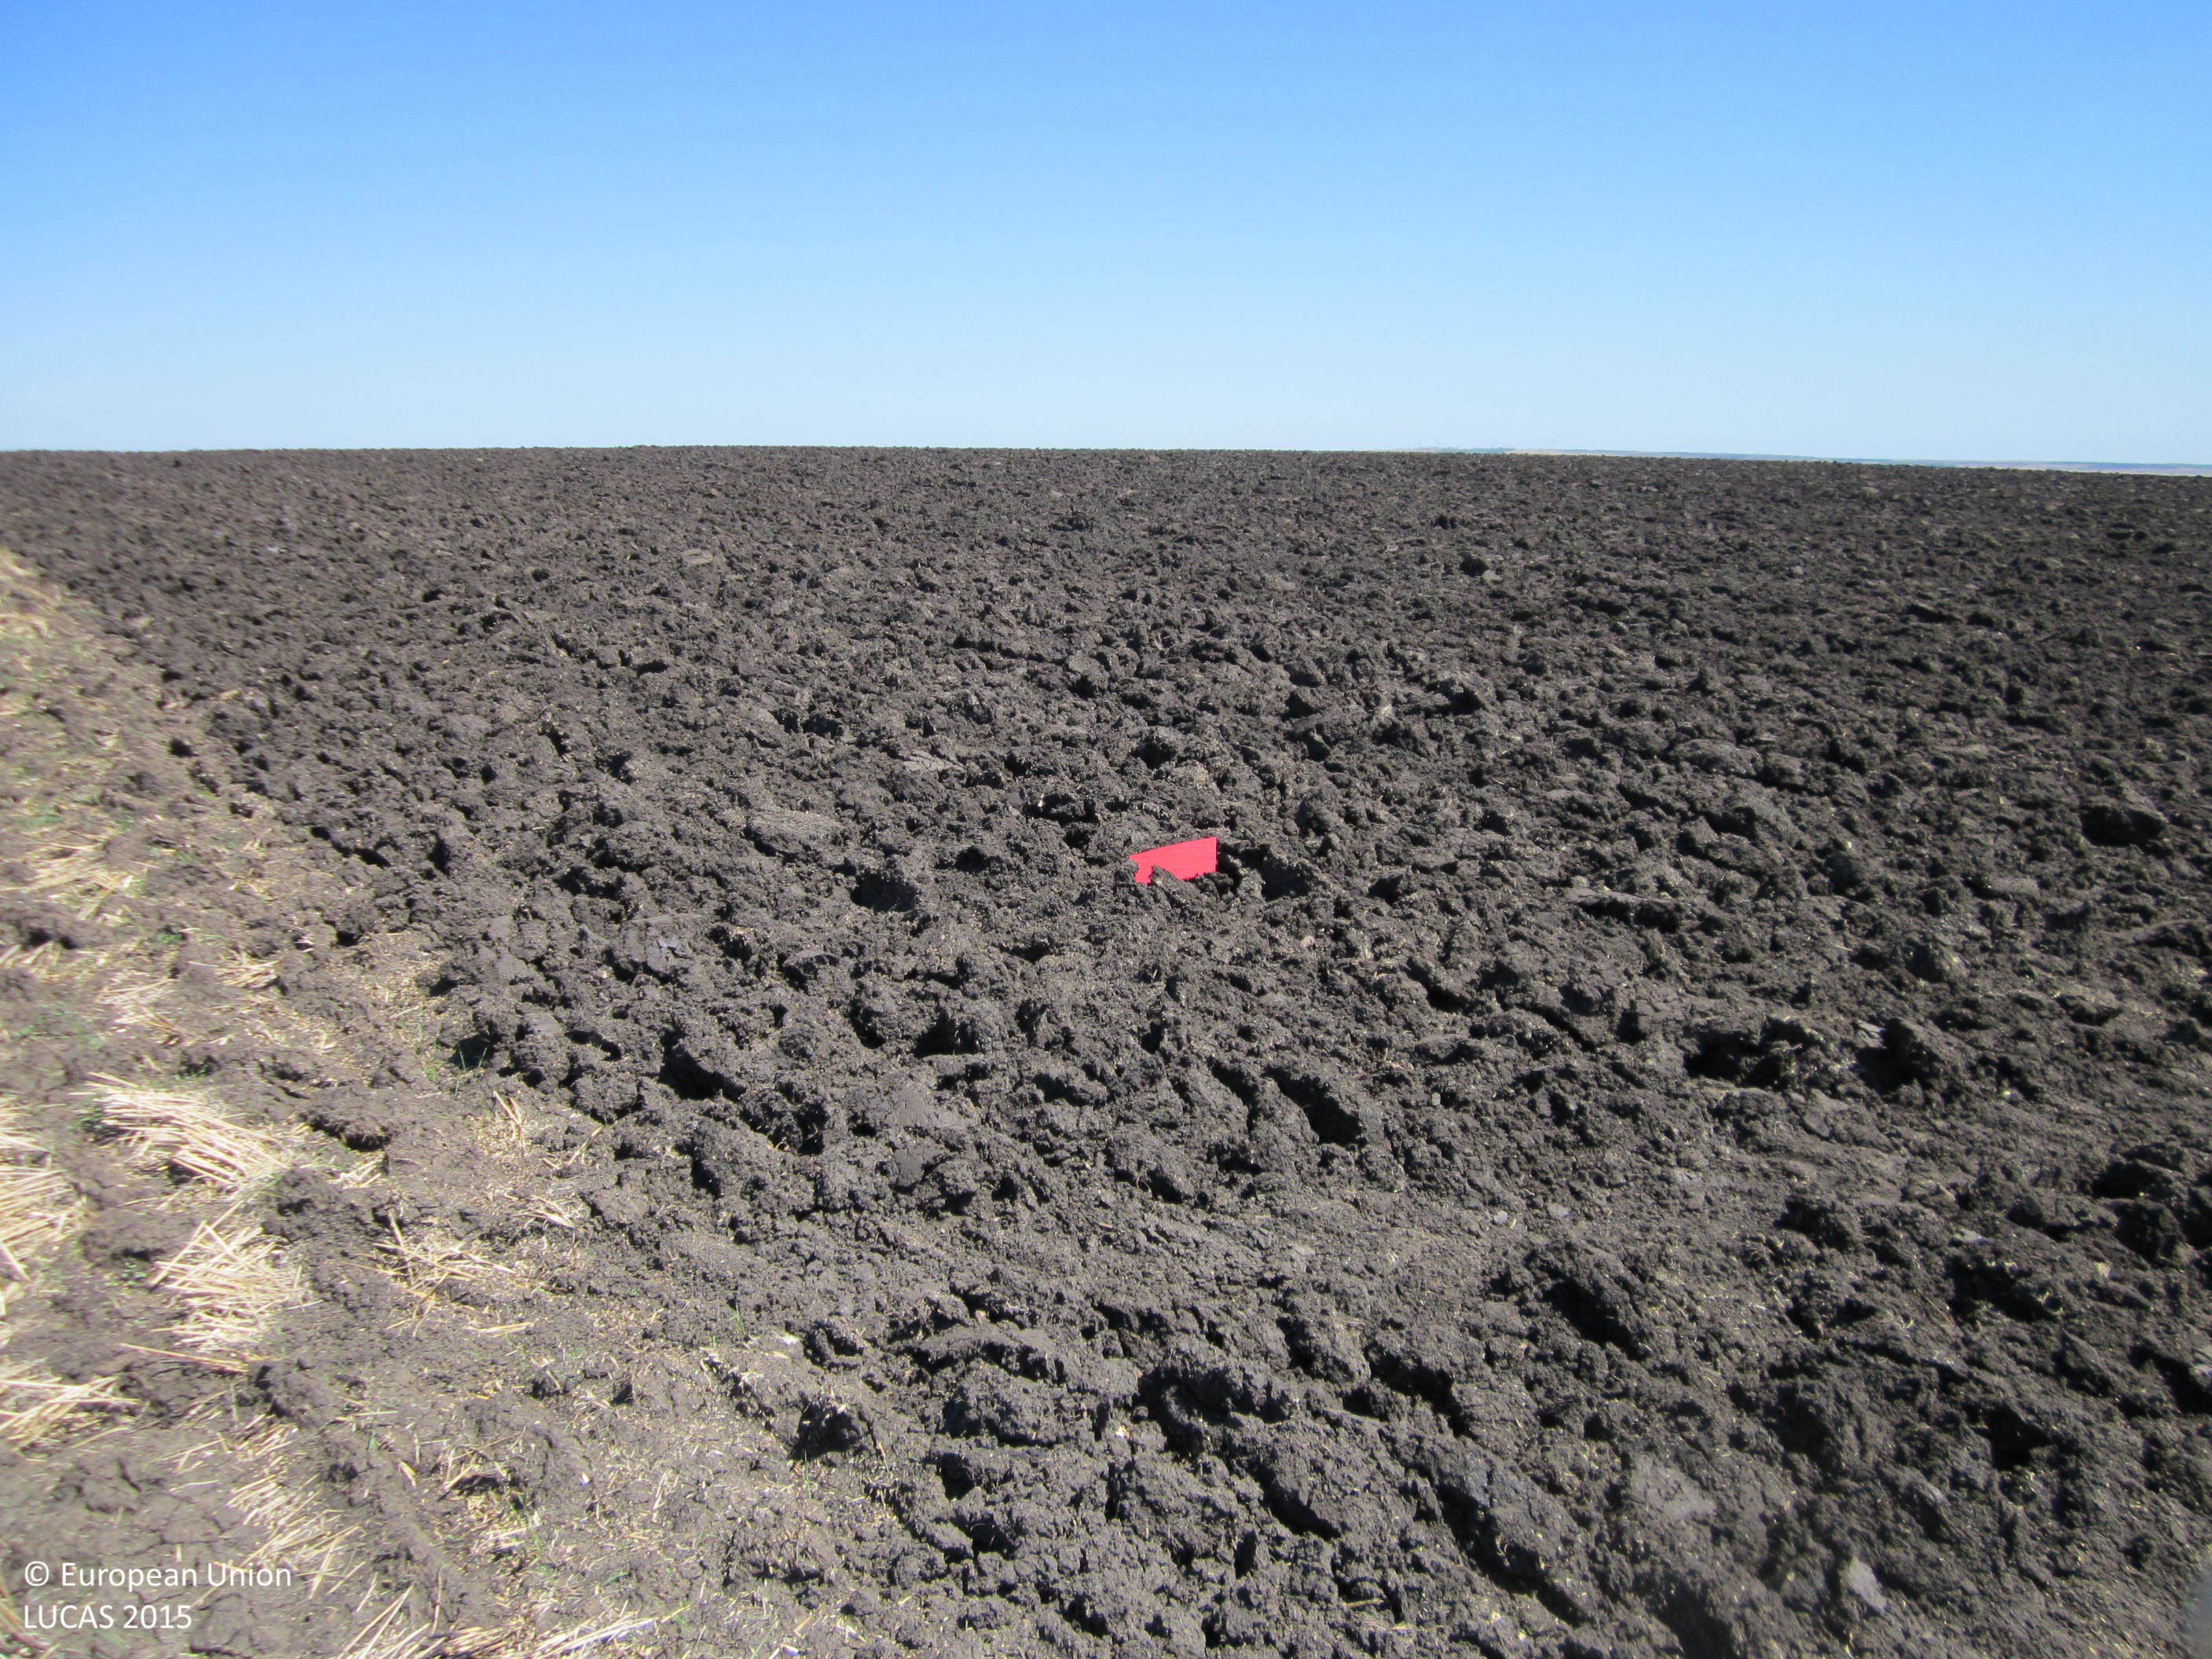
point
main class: Cropland
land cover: Common wheat
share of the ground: < 10 %
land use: Agriculture (excluding fallow land and kitchen gardens)
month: September
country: BG
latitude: 42.5331
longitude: 27.0915
